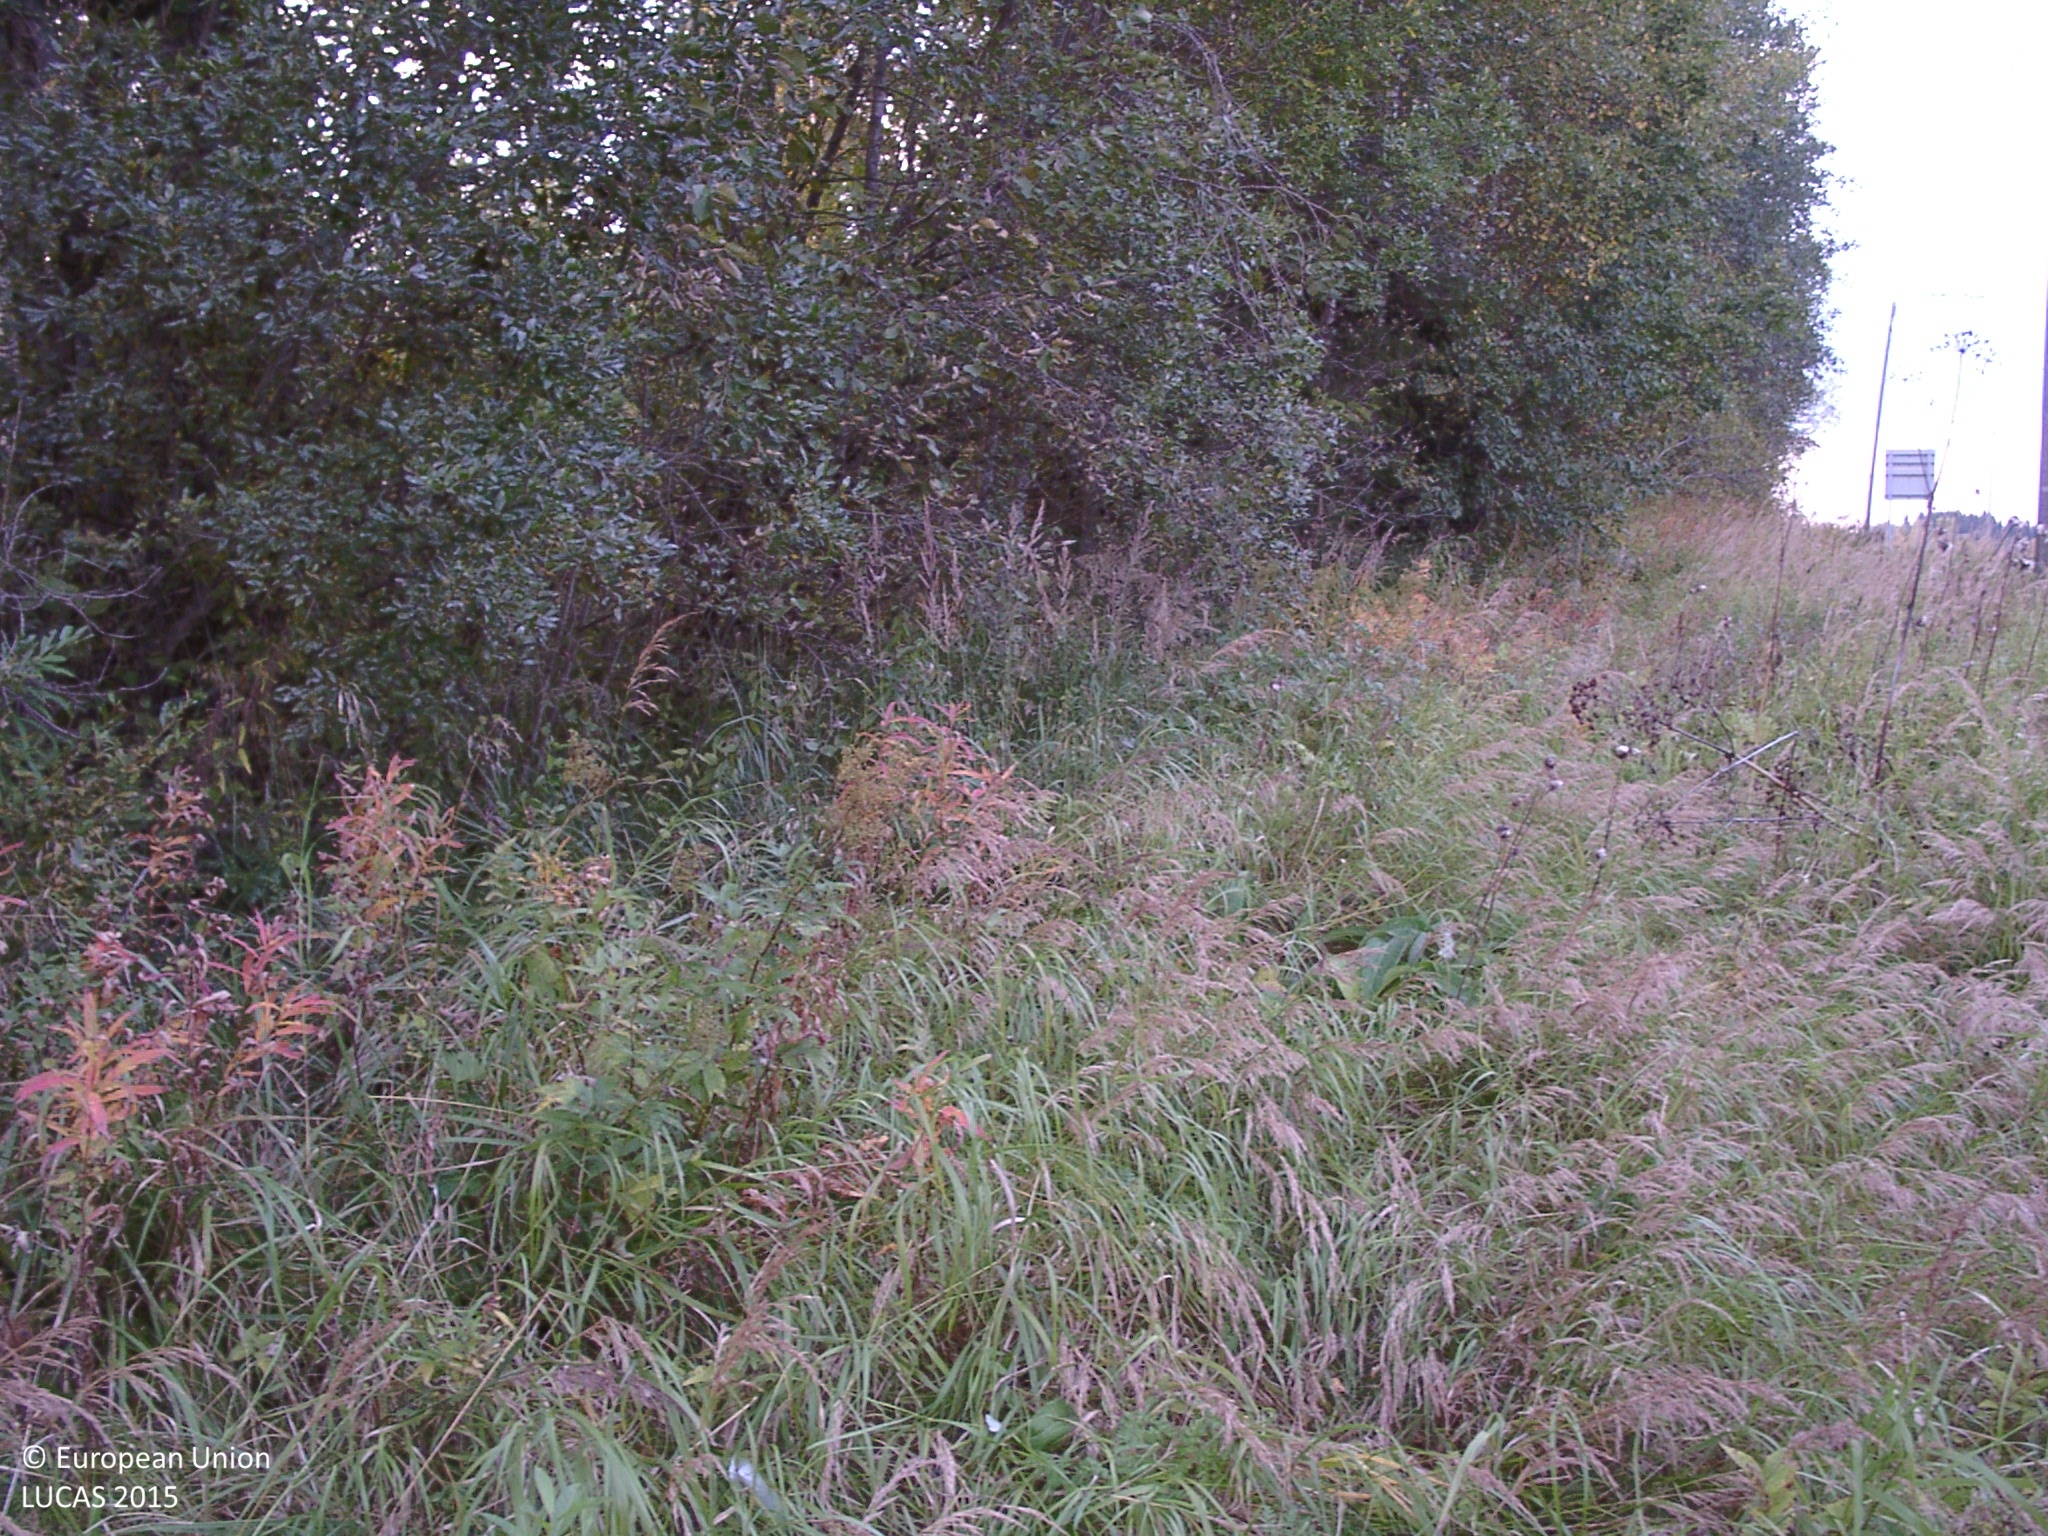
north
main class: Grassland
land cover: Grassland without tree/shrub cover
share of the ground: > 75 %
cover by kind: herbaceous plants 100 %
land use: Road transport
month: September
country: FI
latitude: 62.4087
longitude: 25.6970
